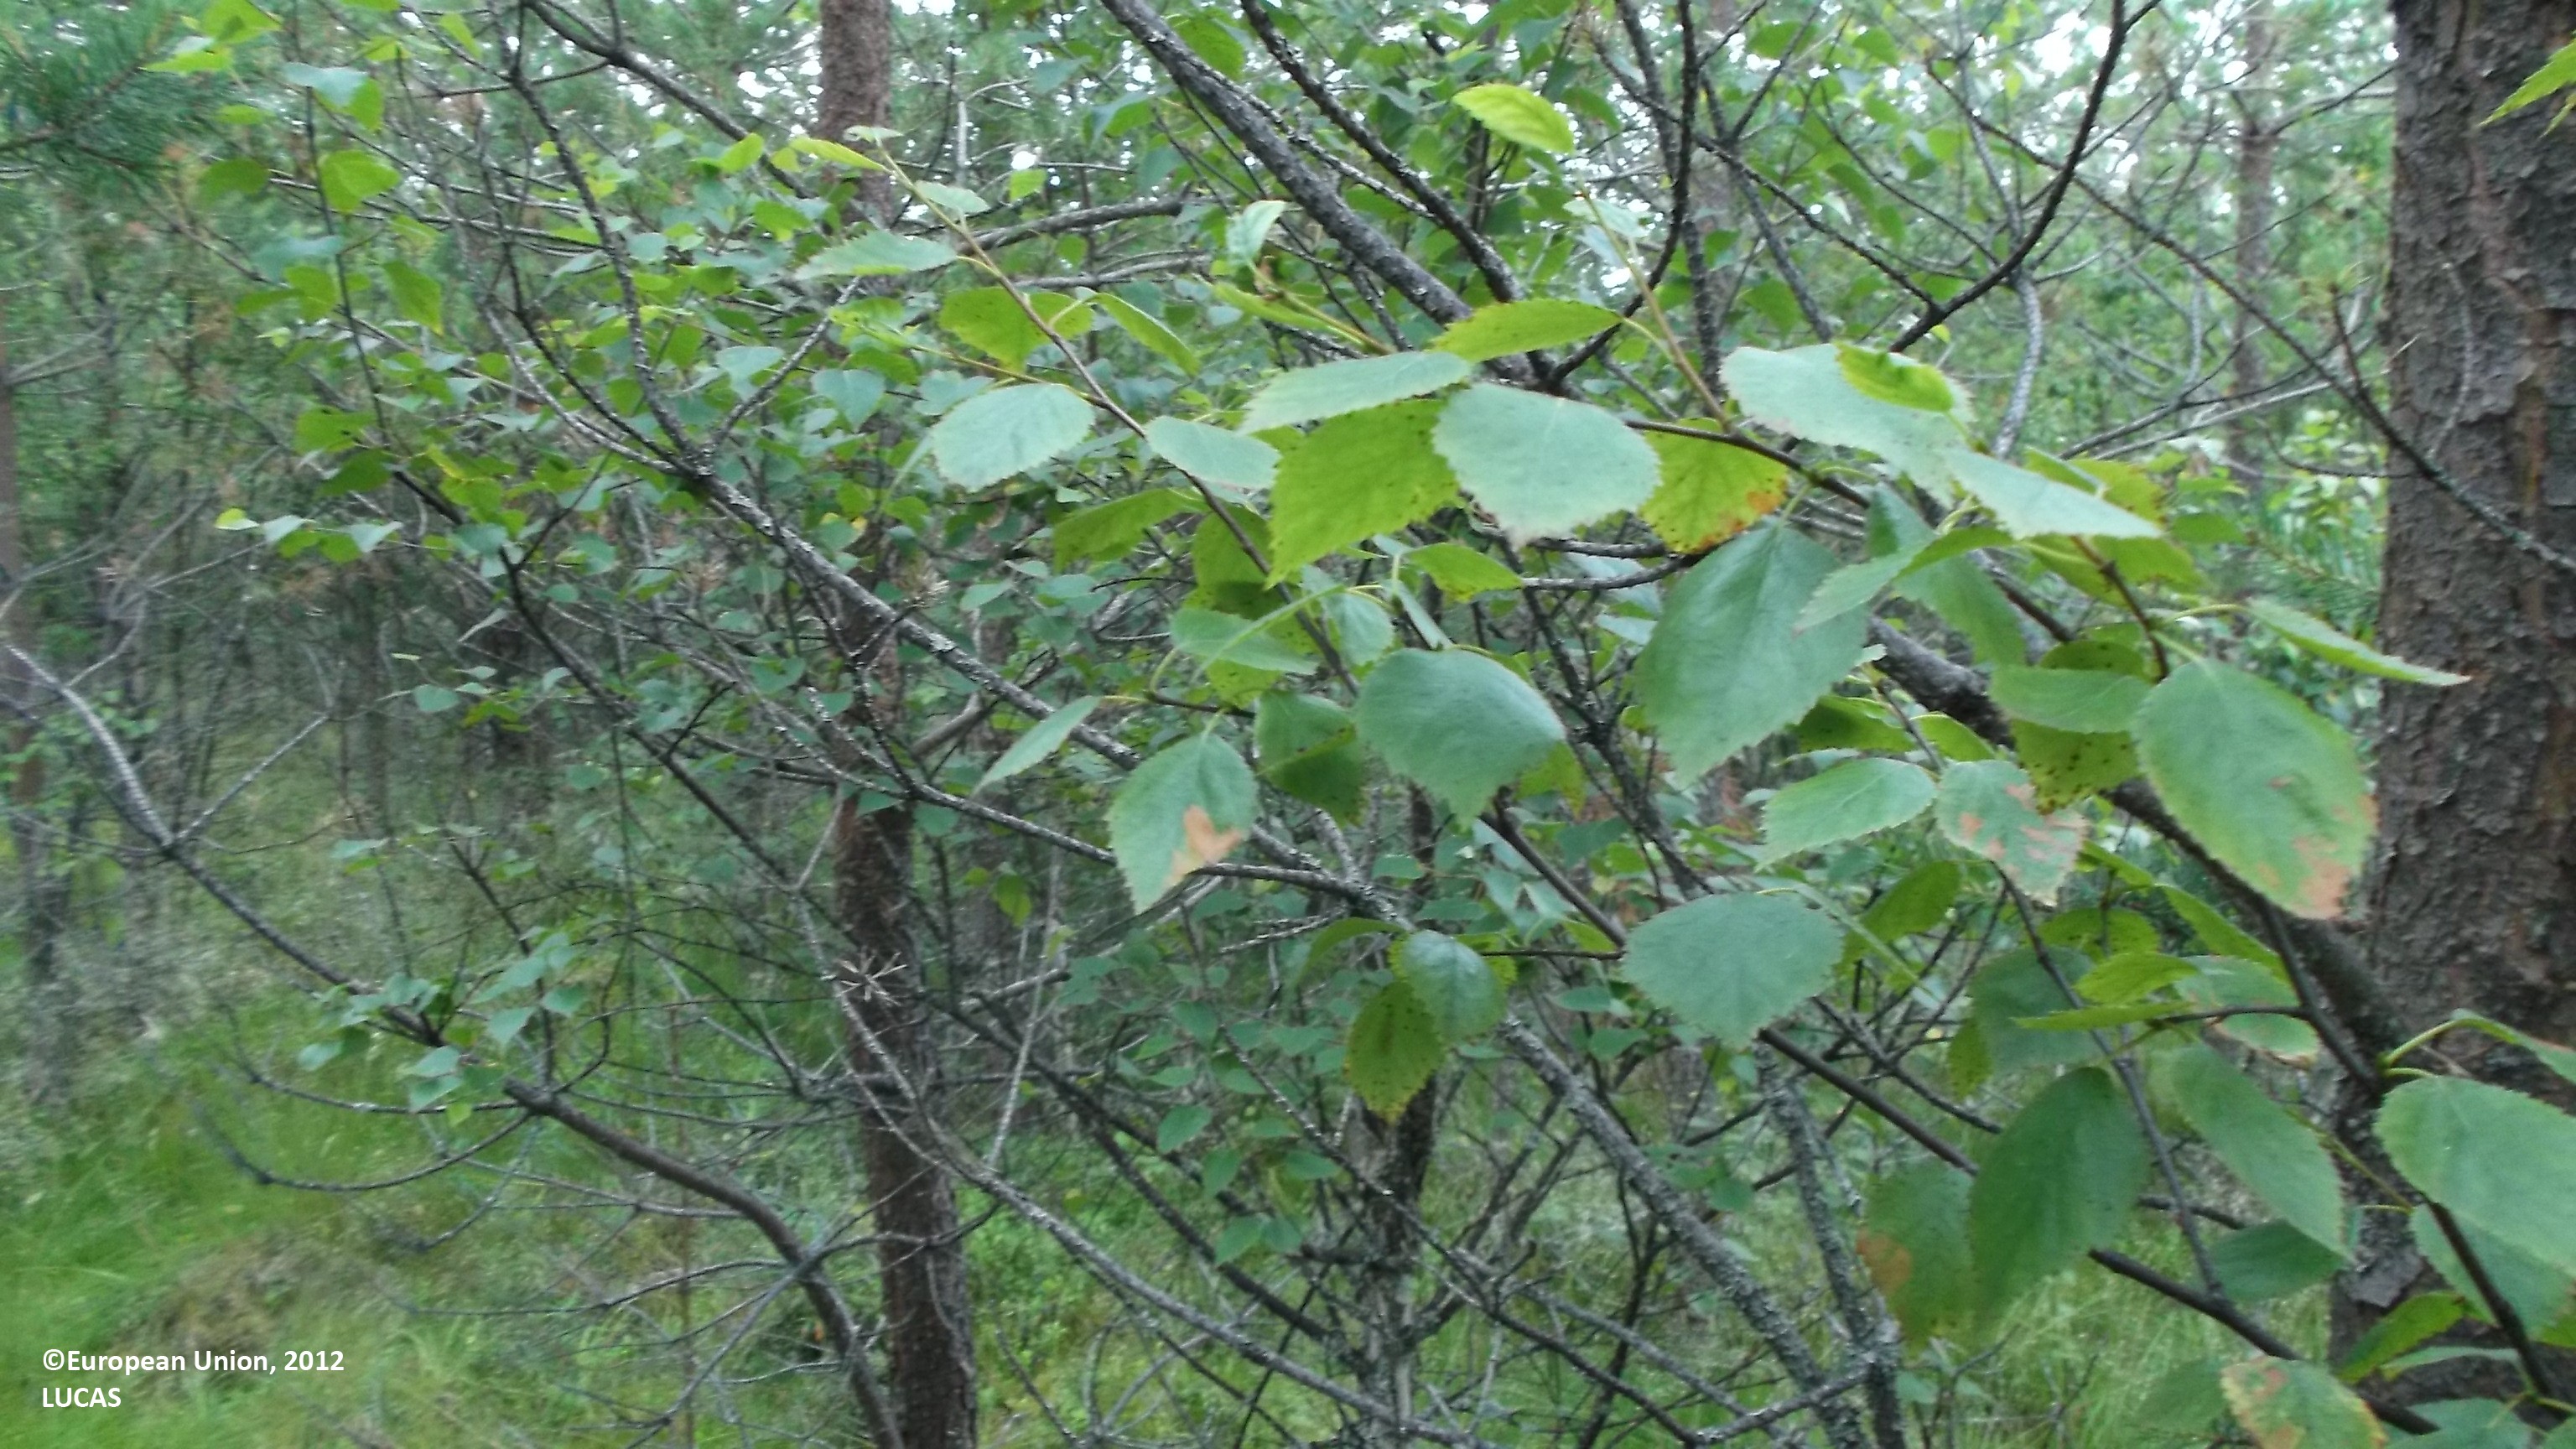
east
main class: Woodland
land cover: Pine dominated mixed woodland
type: boreal forest
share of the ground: > 75 %
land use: Forestry
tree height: > 5 m
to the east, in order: Pine dominated mixed woodland; Pine dominated coniferous woodland; Ditches and canals; Pine dominated coniferous woodland; Ditches and canals; Pine dominated coniferous woodland; Ditches and canals; Pine dominated coniferous woodland
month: July
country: FI
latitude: 63.6068
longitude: 23.1821
